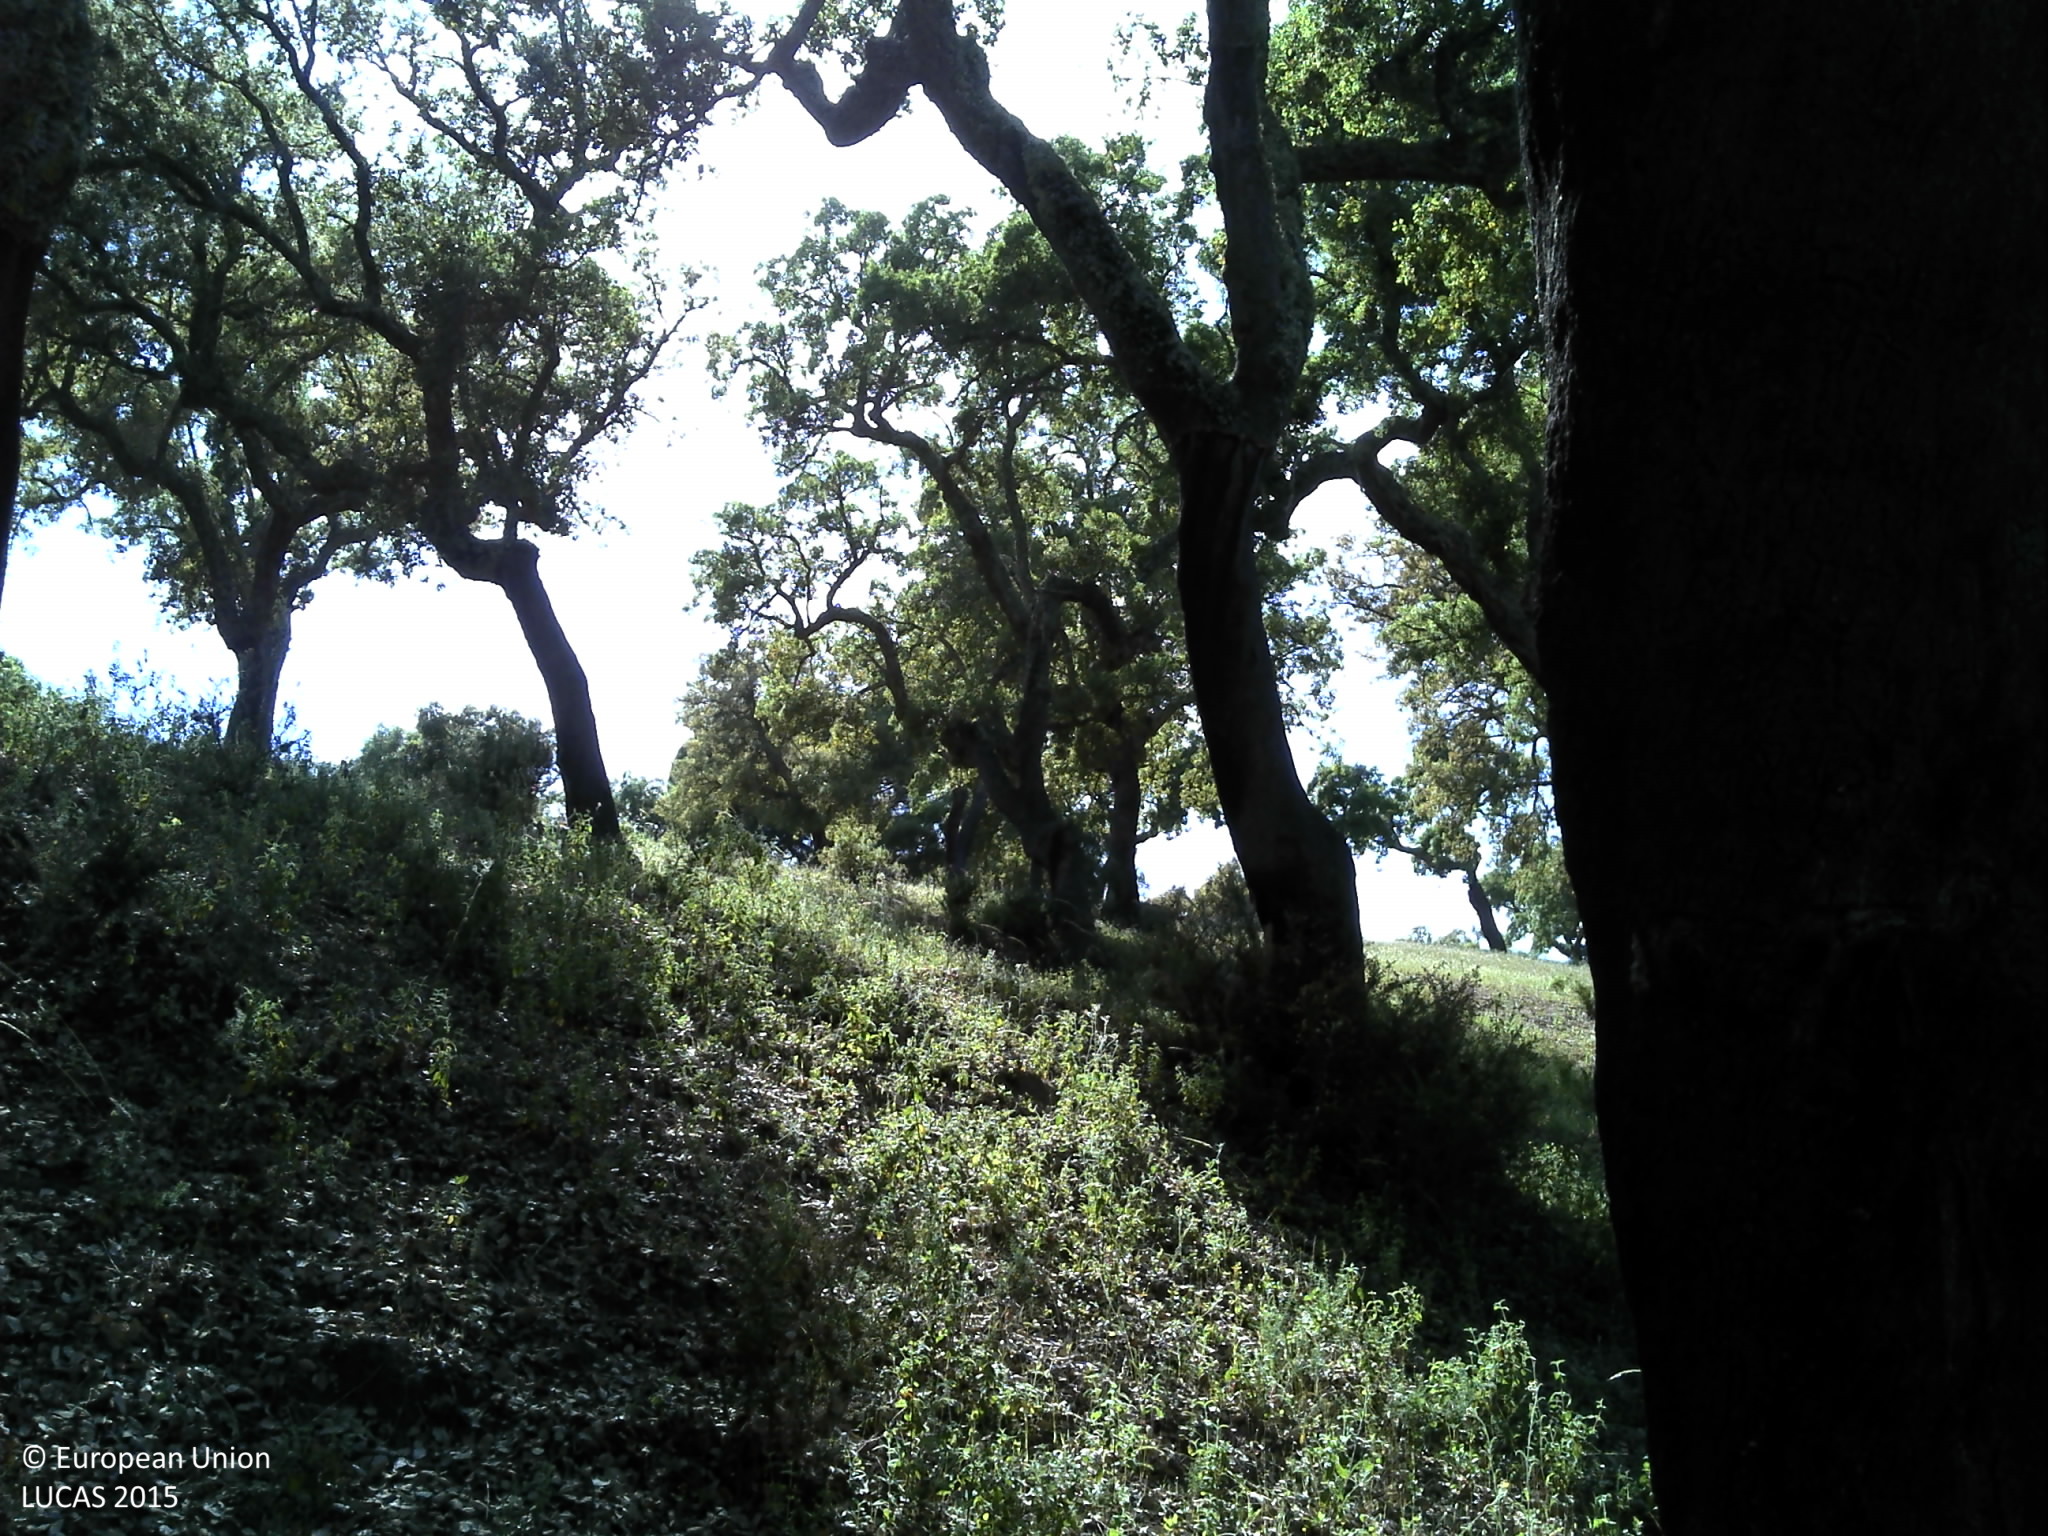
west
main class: Woodland
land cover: Broadleaved woodland
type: broadleaved evergreen forest
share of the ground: 50 - 75 %
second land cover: Grassland without tree/shrub cover
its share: 10 - 25 %
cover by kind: broadleaved forest trees 75 %, herbaceous plants 15 %, unconsolidated bare surface 10 %
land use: Forestry
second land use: Agriculture (excluding fallow land and kitchen gardens)
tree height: > 5 m
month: May
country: PT
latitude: 38.9806
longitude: -8.1656
